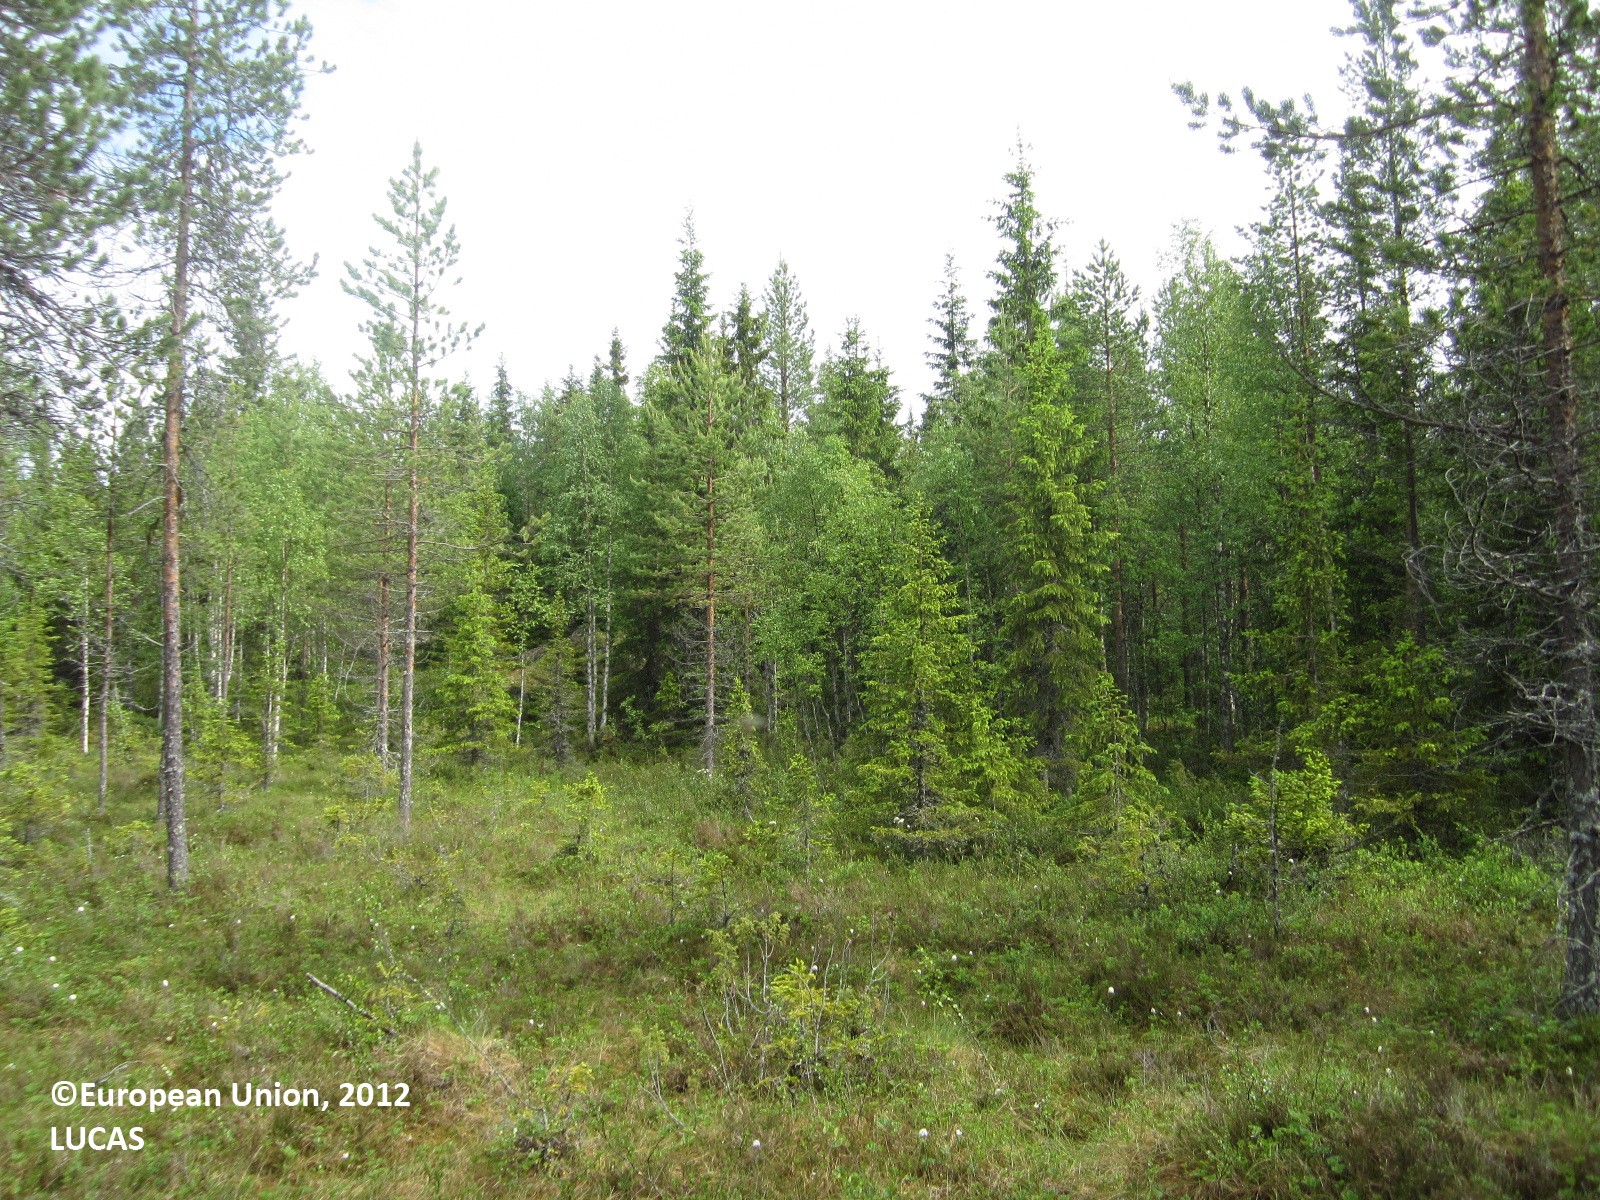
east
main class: Woodland
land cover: Pine dominated coniferous woodland
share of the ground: 10 - 25 %
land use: Semi-natural and natural areas not in use
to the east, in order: Pine dominated coniferous woodland; Rocks and stones; Lichens and moss; Pine dominated coniferous woodland; Spontaneously vegetated surfaces; Pine dominated coniferous woodland; Rock outcrops; Shrubland without tree cover; Pine dominated coniferous woodland
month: June
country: FI
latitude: 64.6393
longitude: 29.8752
